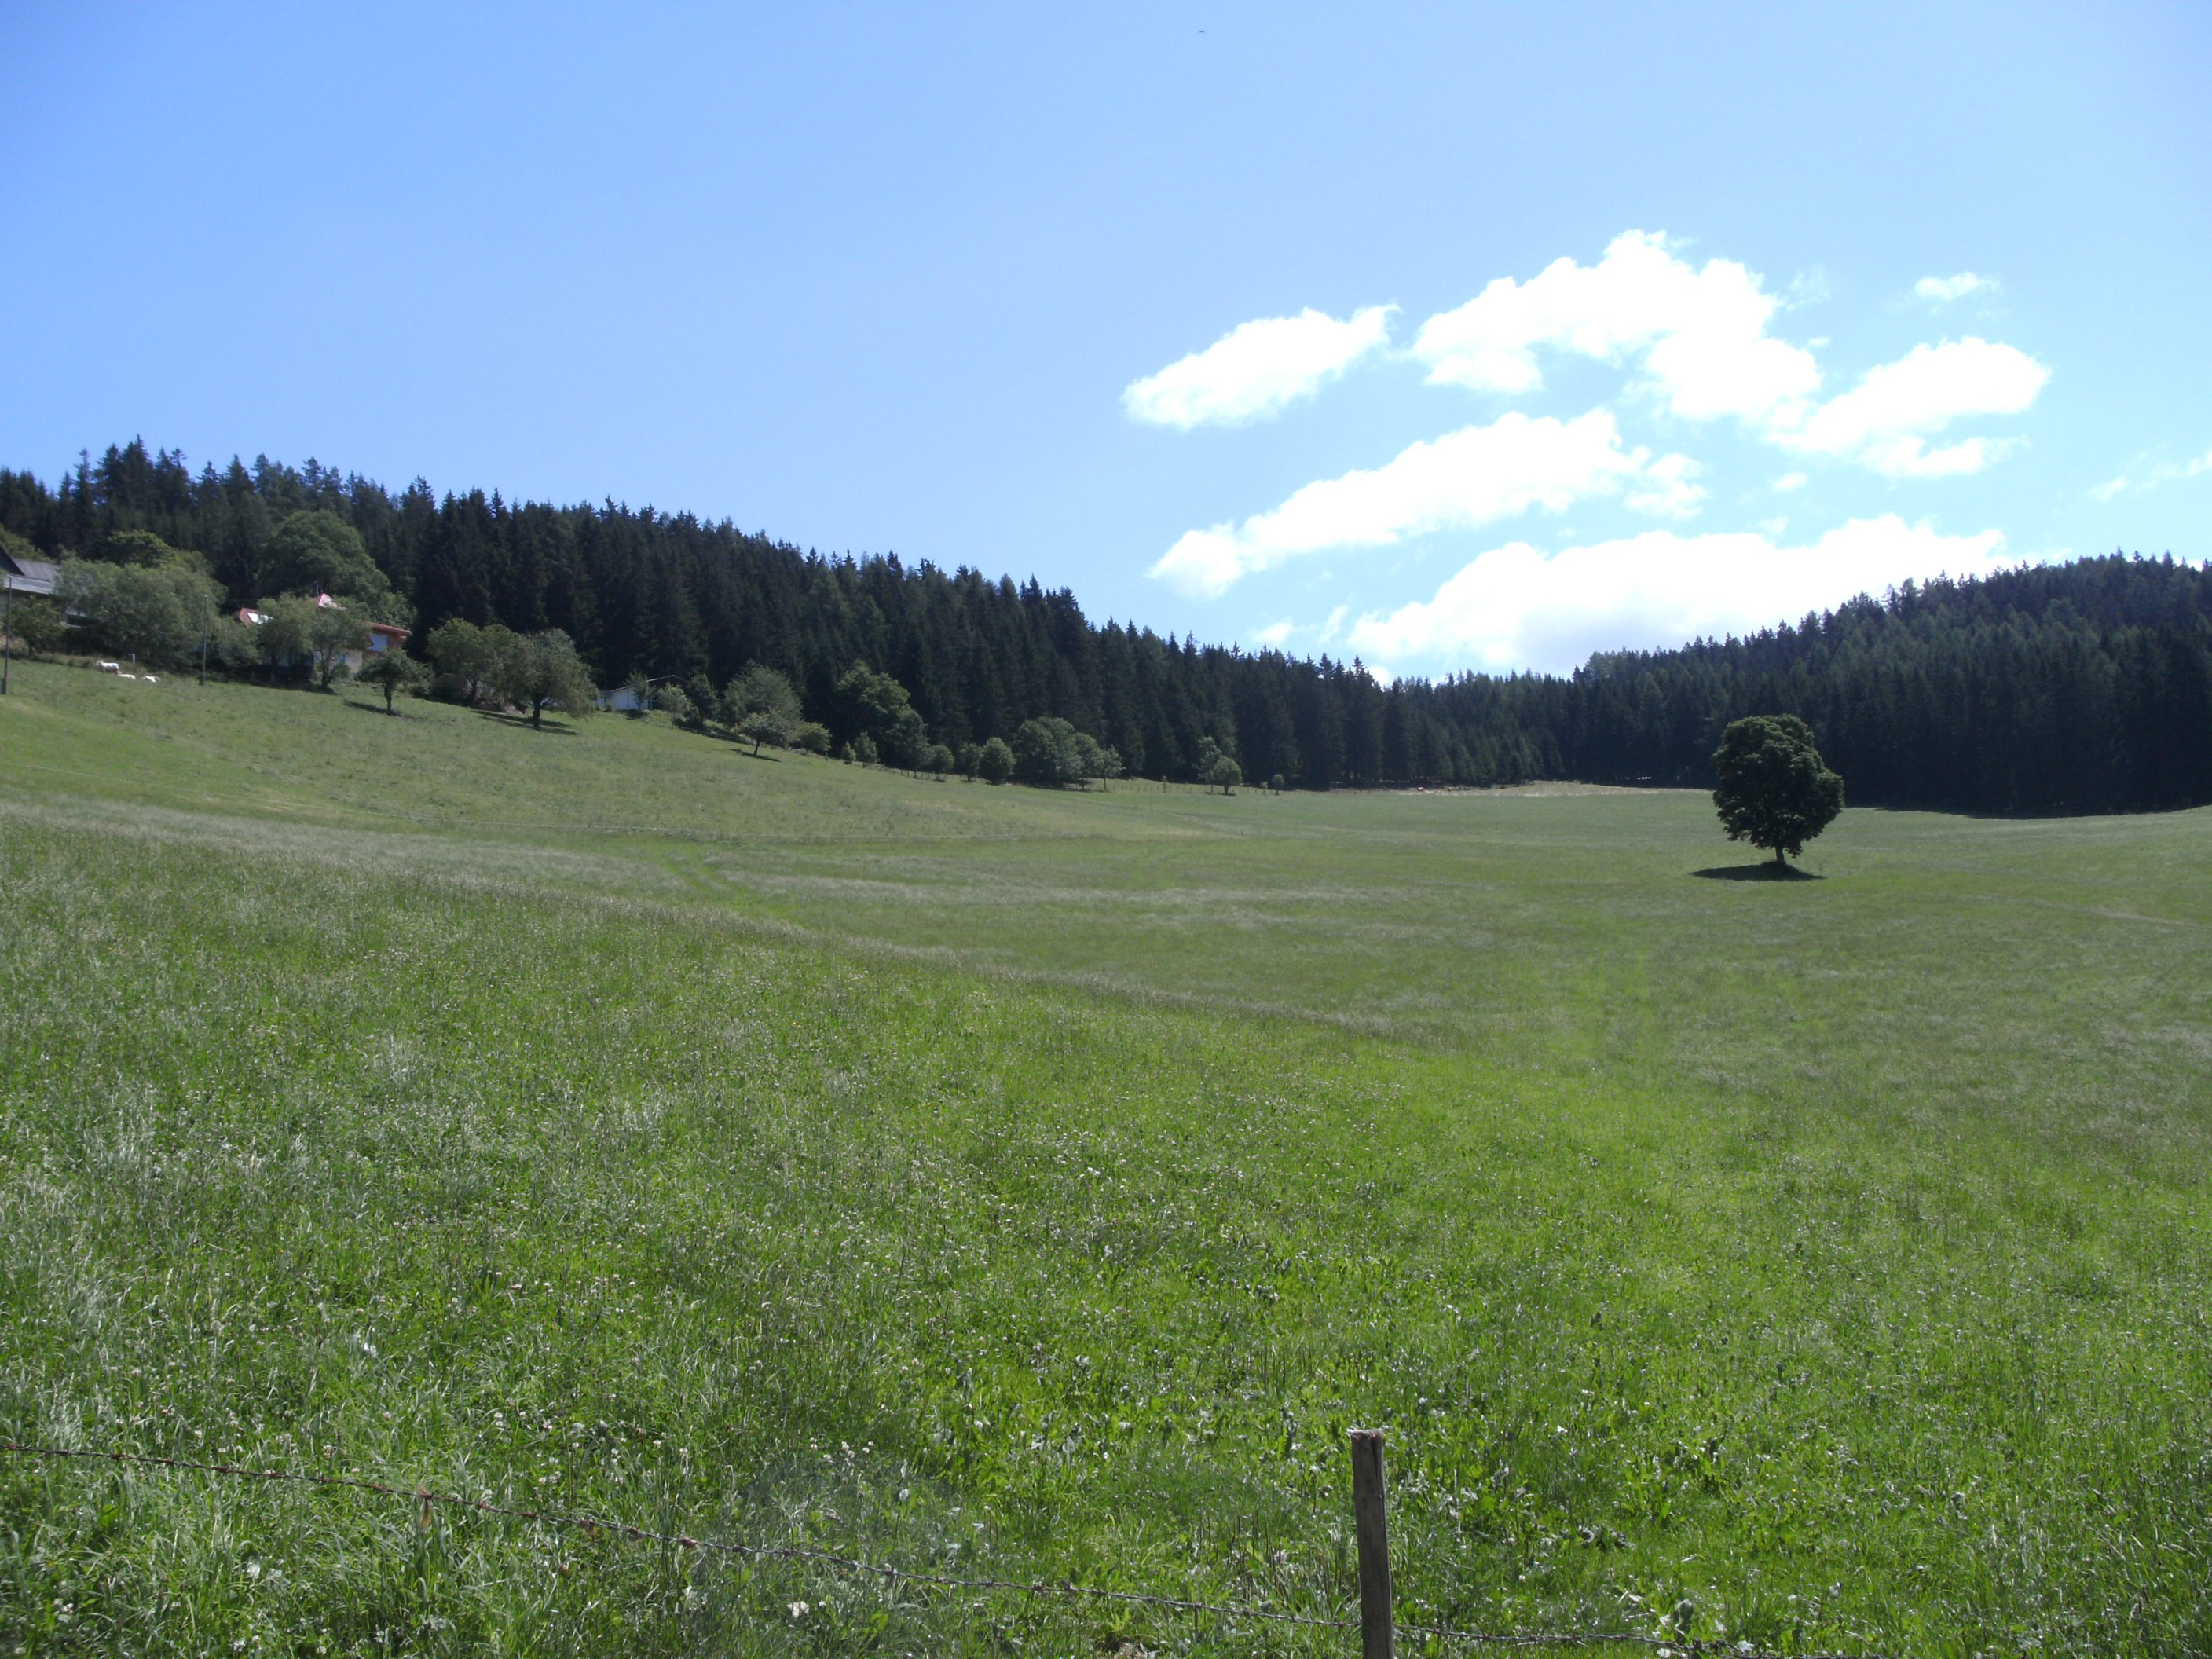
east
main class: Grassland
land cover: Grassland without tree/shrub cover
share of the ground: > 75 %
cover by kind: herbaceous plants 100 %
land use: Agriculture (excluding fallow land and kitchen gardens)
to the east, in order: Grassland without tree/shrub cover; Fences; Lines of trees; Grass margins; Fences; Paved roads, cycling and walking lanes; Fences; Grassland without tree/shrub cover
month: July
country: AT
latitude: 46.9067
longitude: 14.8955
